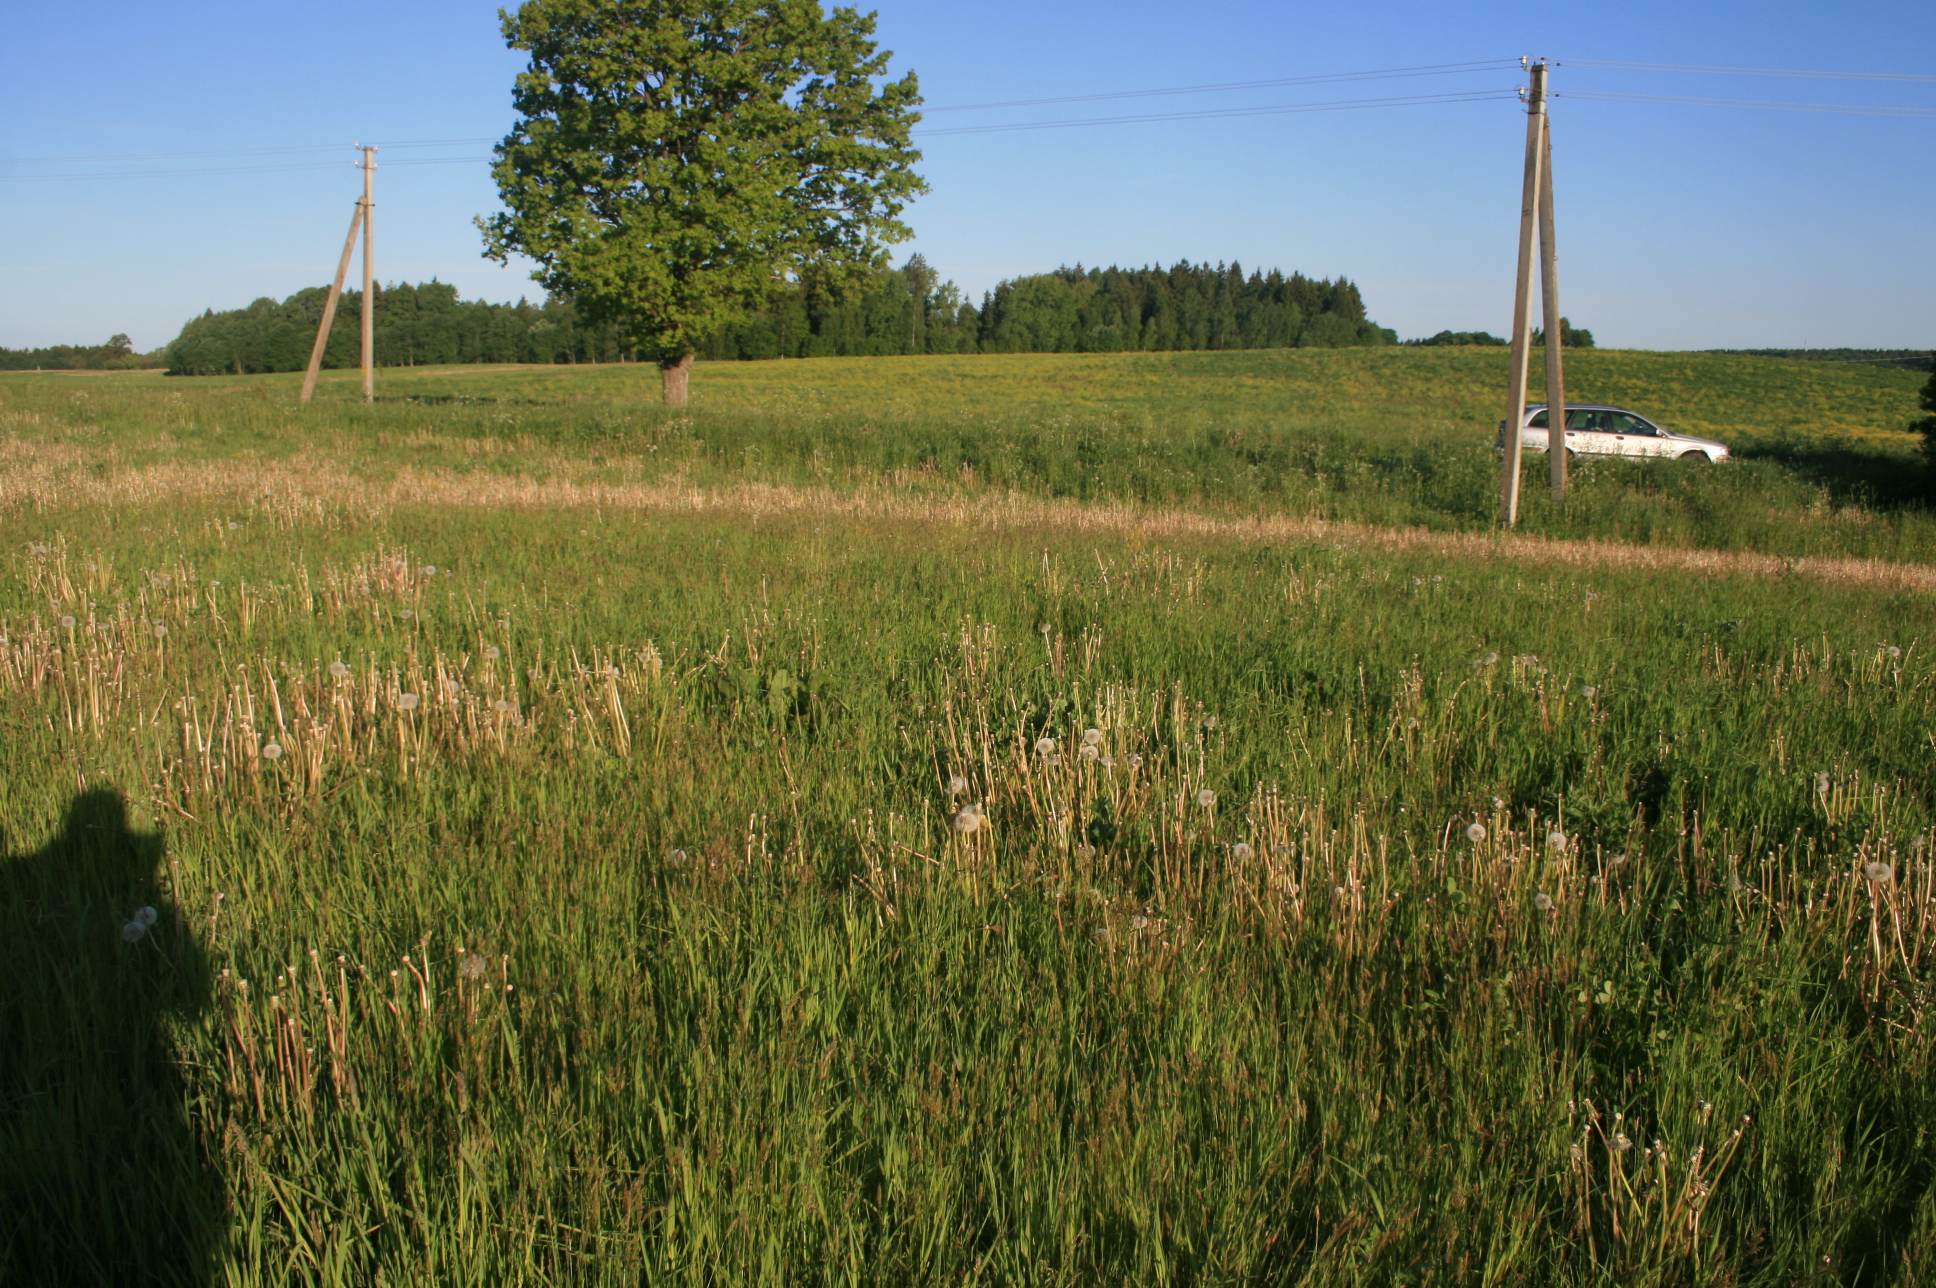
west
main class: Grassland
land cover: Grassland without tree/shrub cover
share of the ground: > 75 %
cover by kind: herbaceous plants 100 %
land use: Agriculture (excluding fallow land and kitchen gardens)
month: June
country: LT
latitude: 55.8984
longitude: 21.9658
